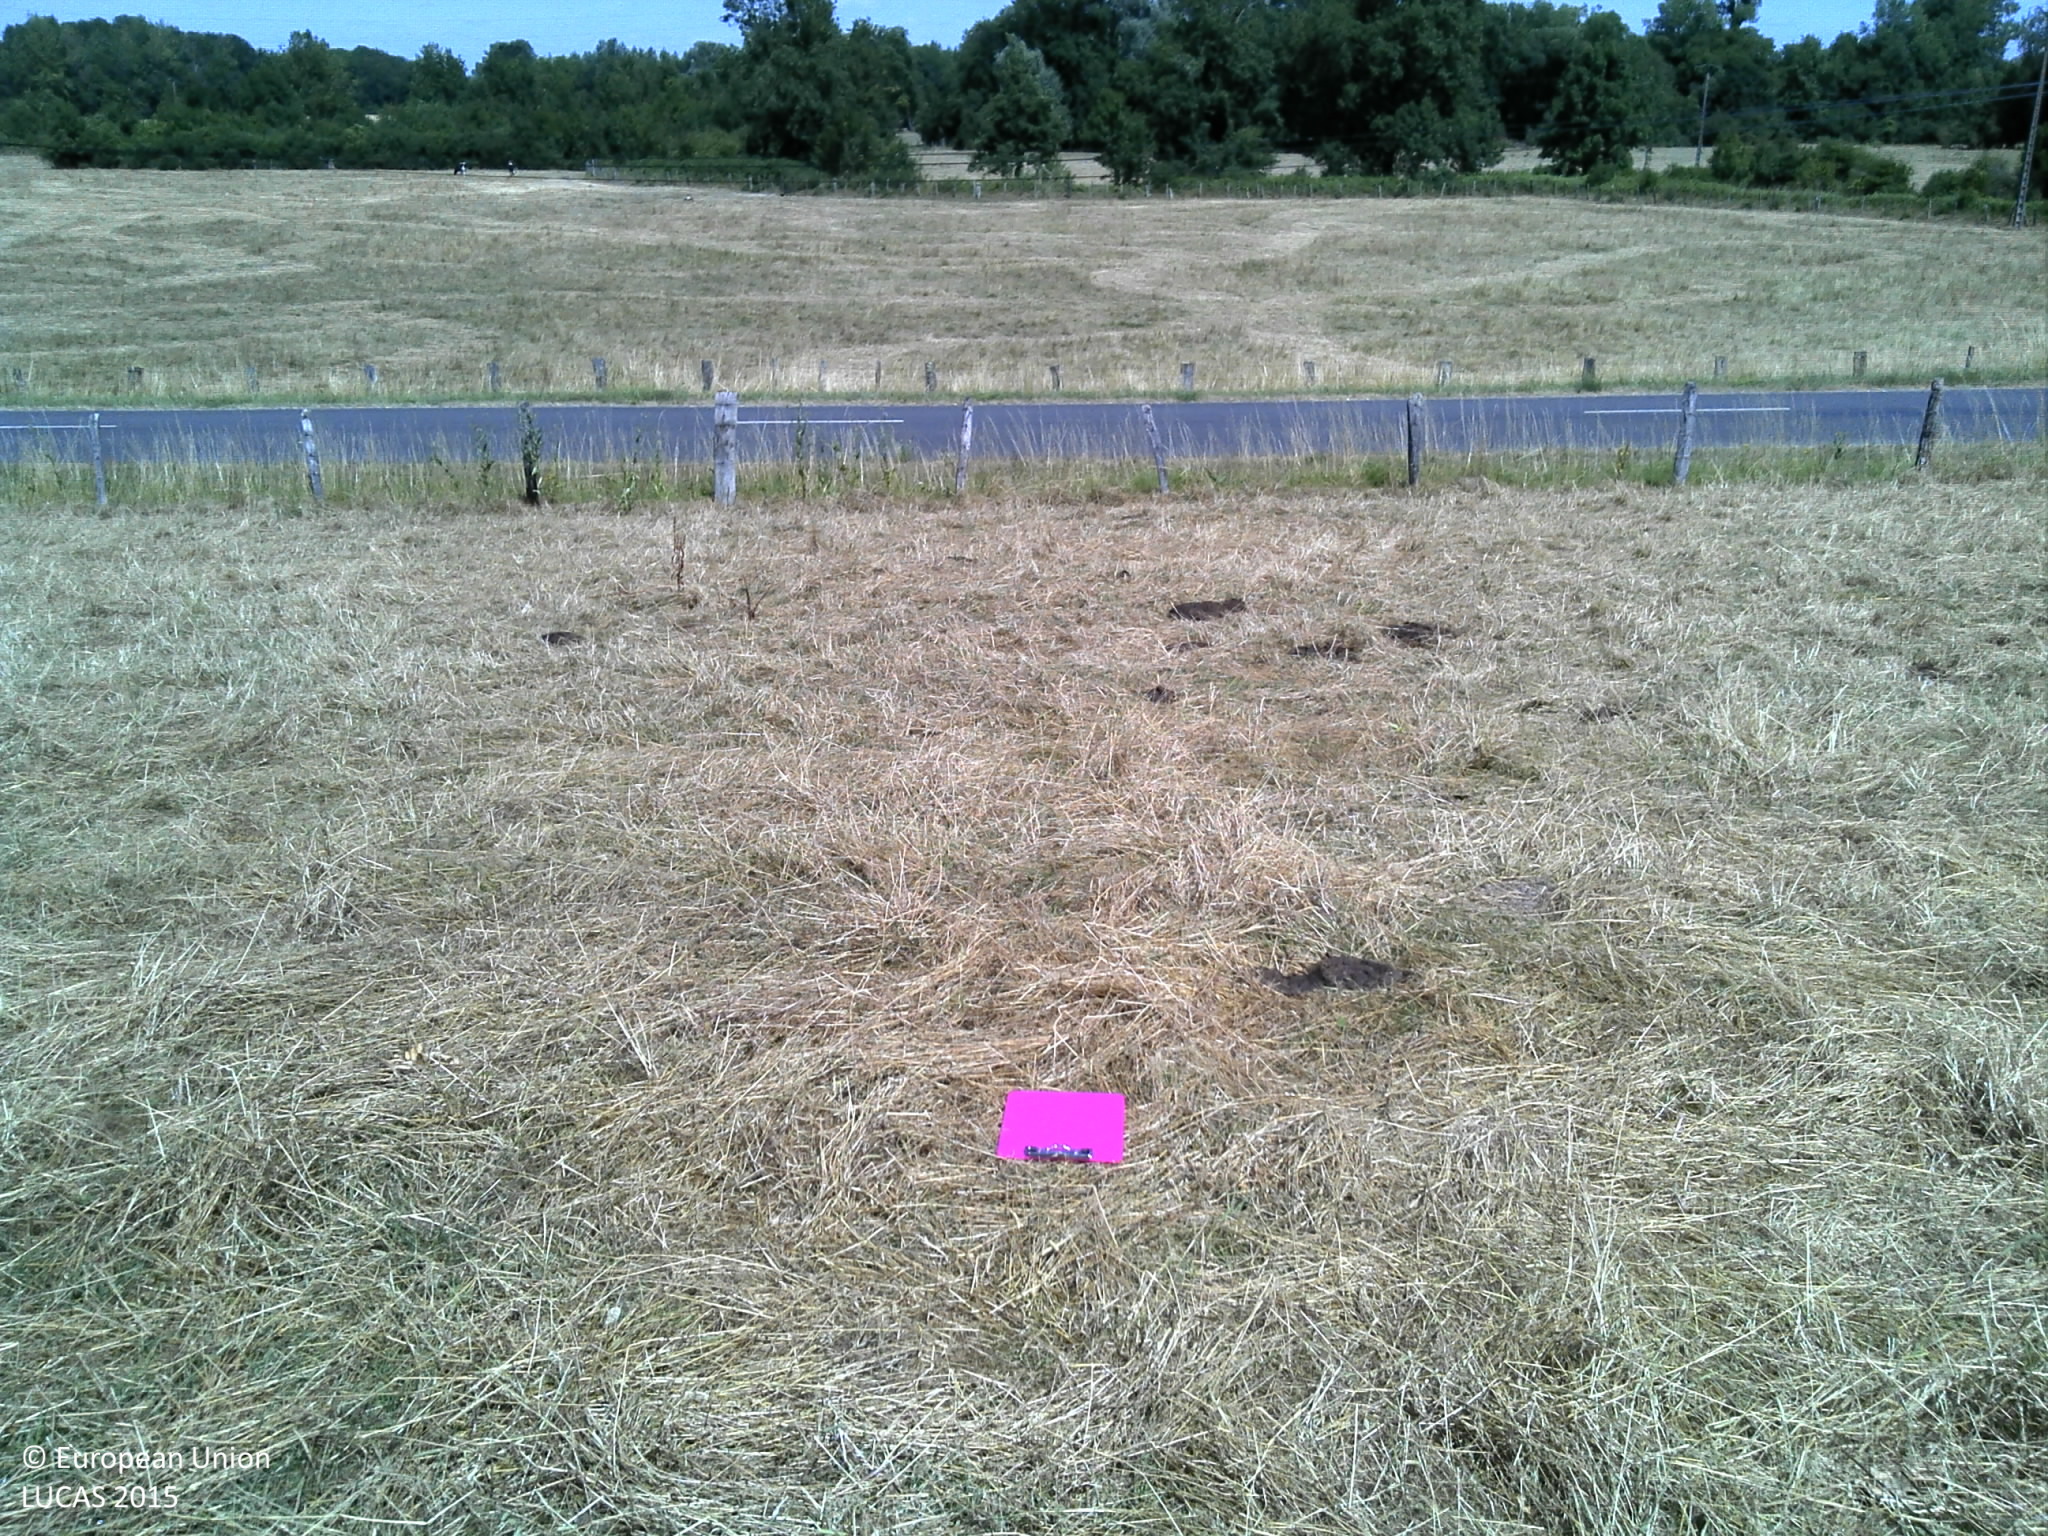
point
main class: Grassland
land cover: Grassland without tree/shrub cover
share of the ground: > 75 %
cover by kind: herbaceous plants 100 %
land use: Agriculture (excluding fallow land and kitchen gardens)
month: July
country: FR
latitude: 48.6200
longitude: 4.7205
